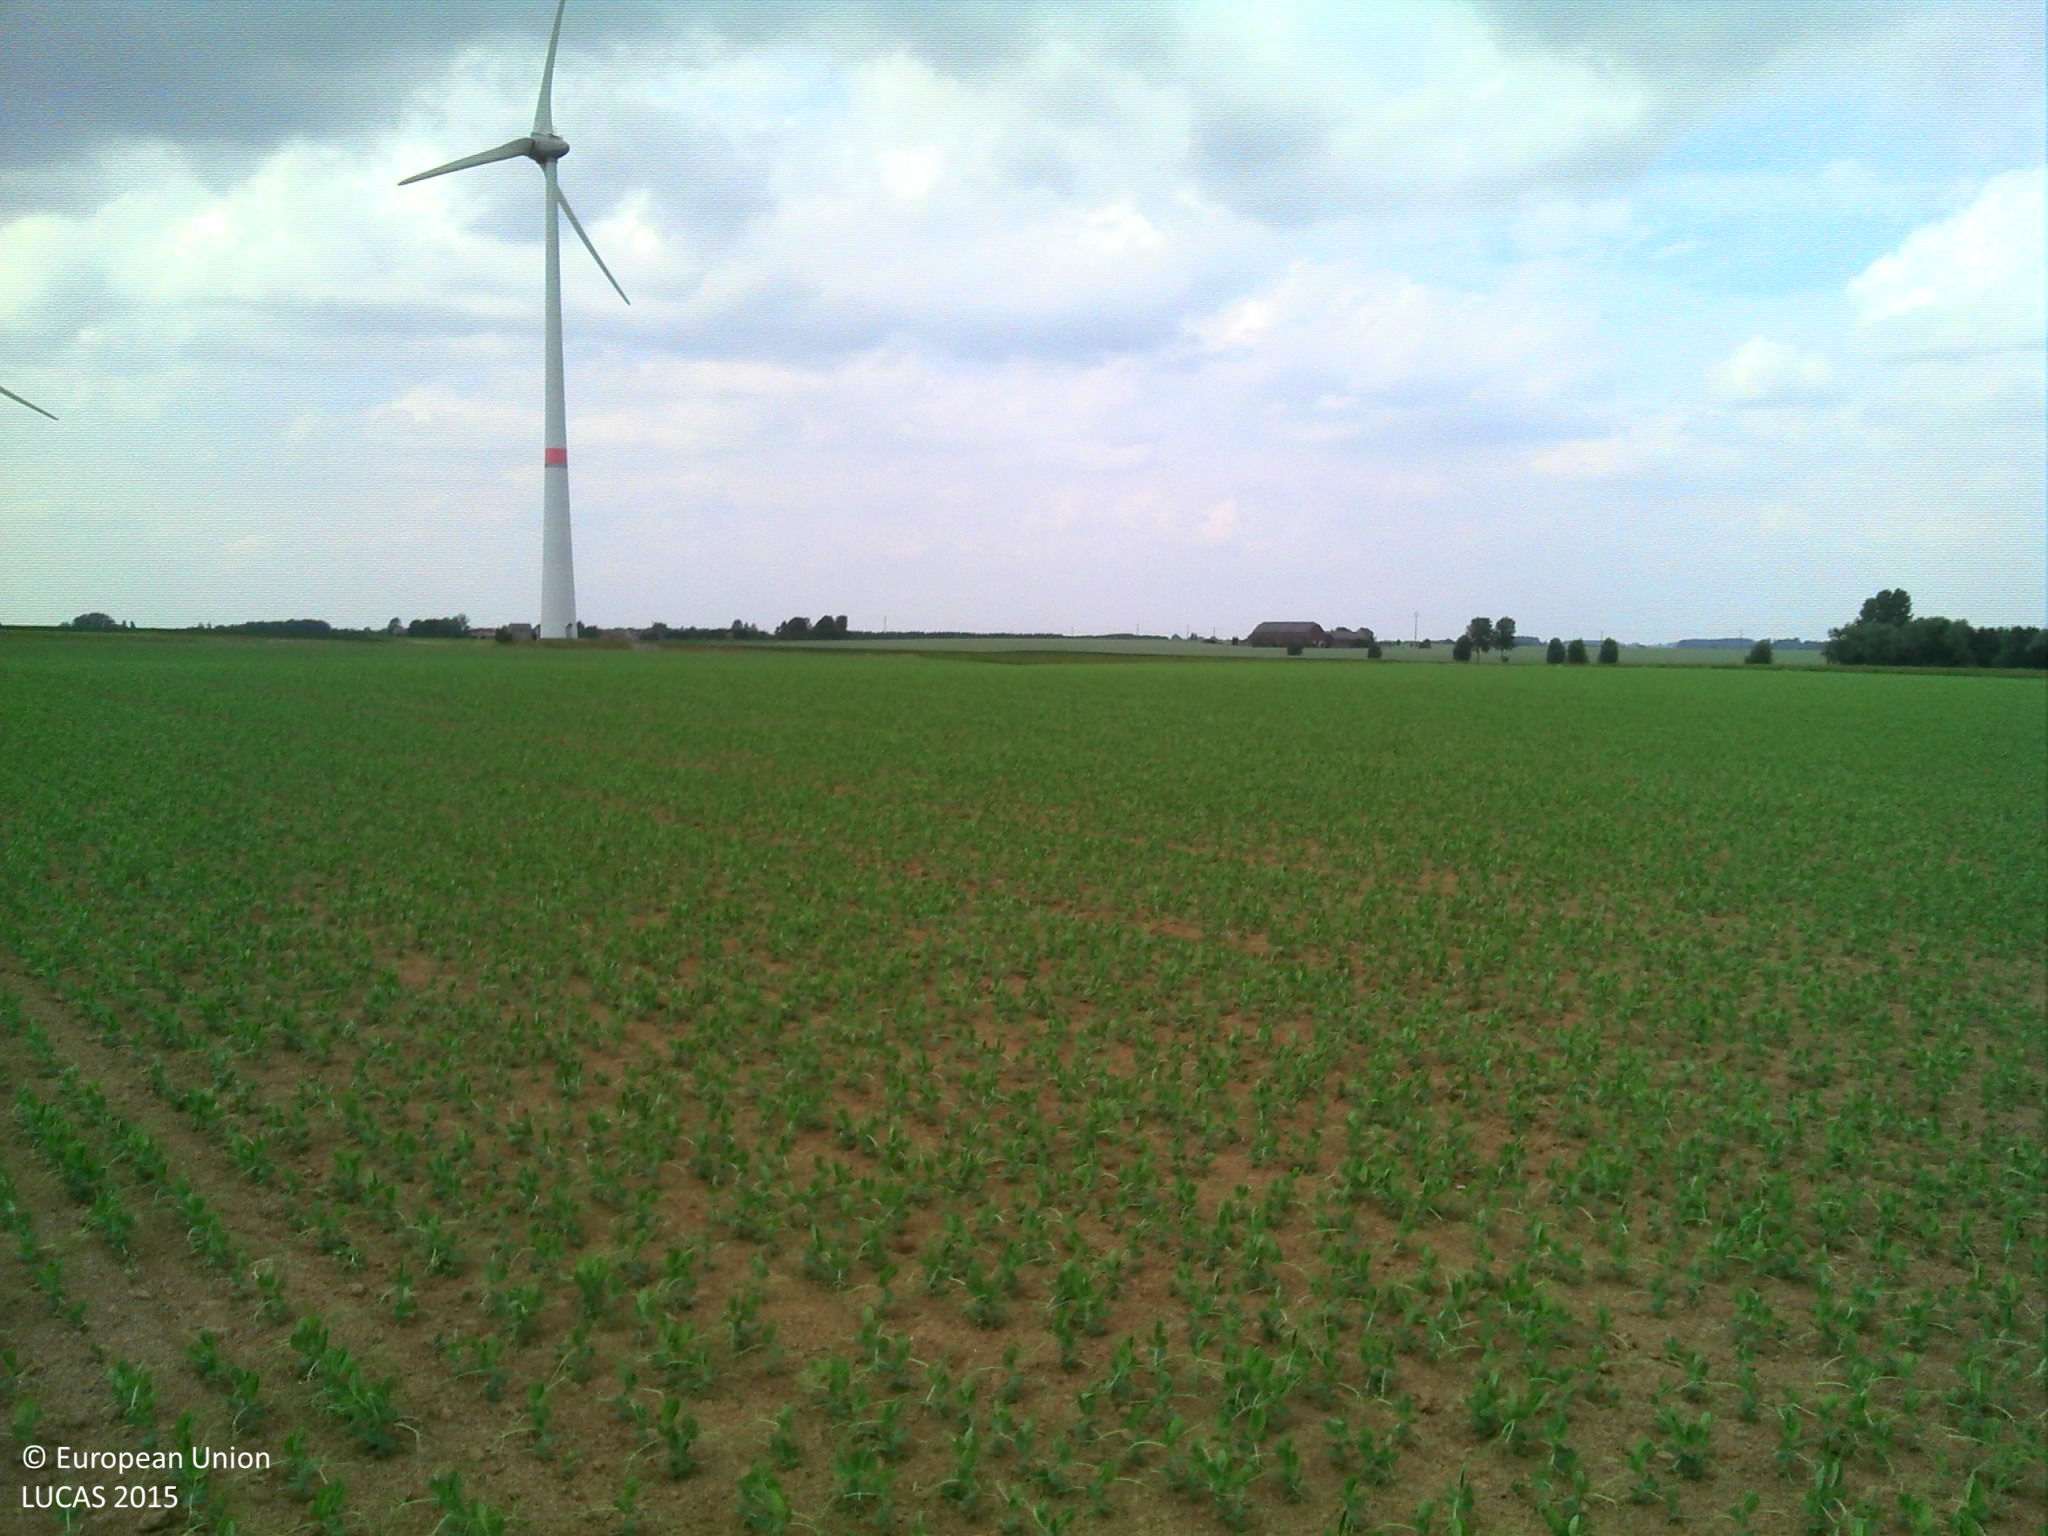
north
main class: Cropland
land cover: Other fresh vegetables
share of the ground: < 10 %
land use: Agriculture (excluding fallow land and kitchen gardens)
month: June
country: BE
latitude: 50.5375
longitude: 4.8751
